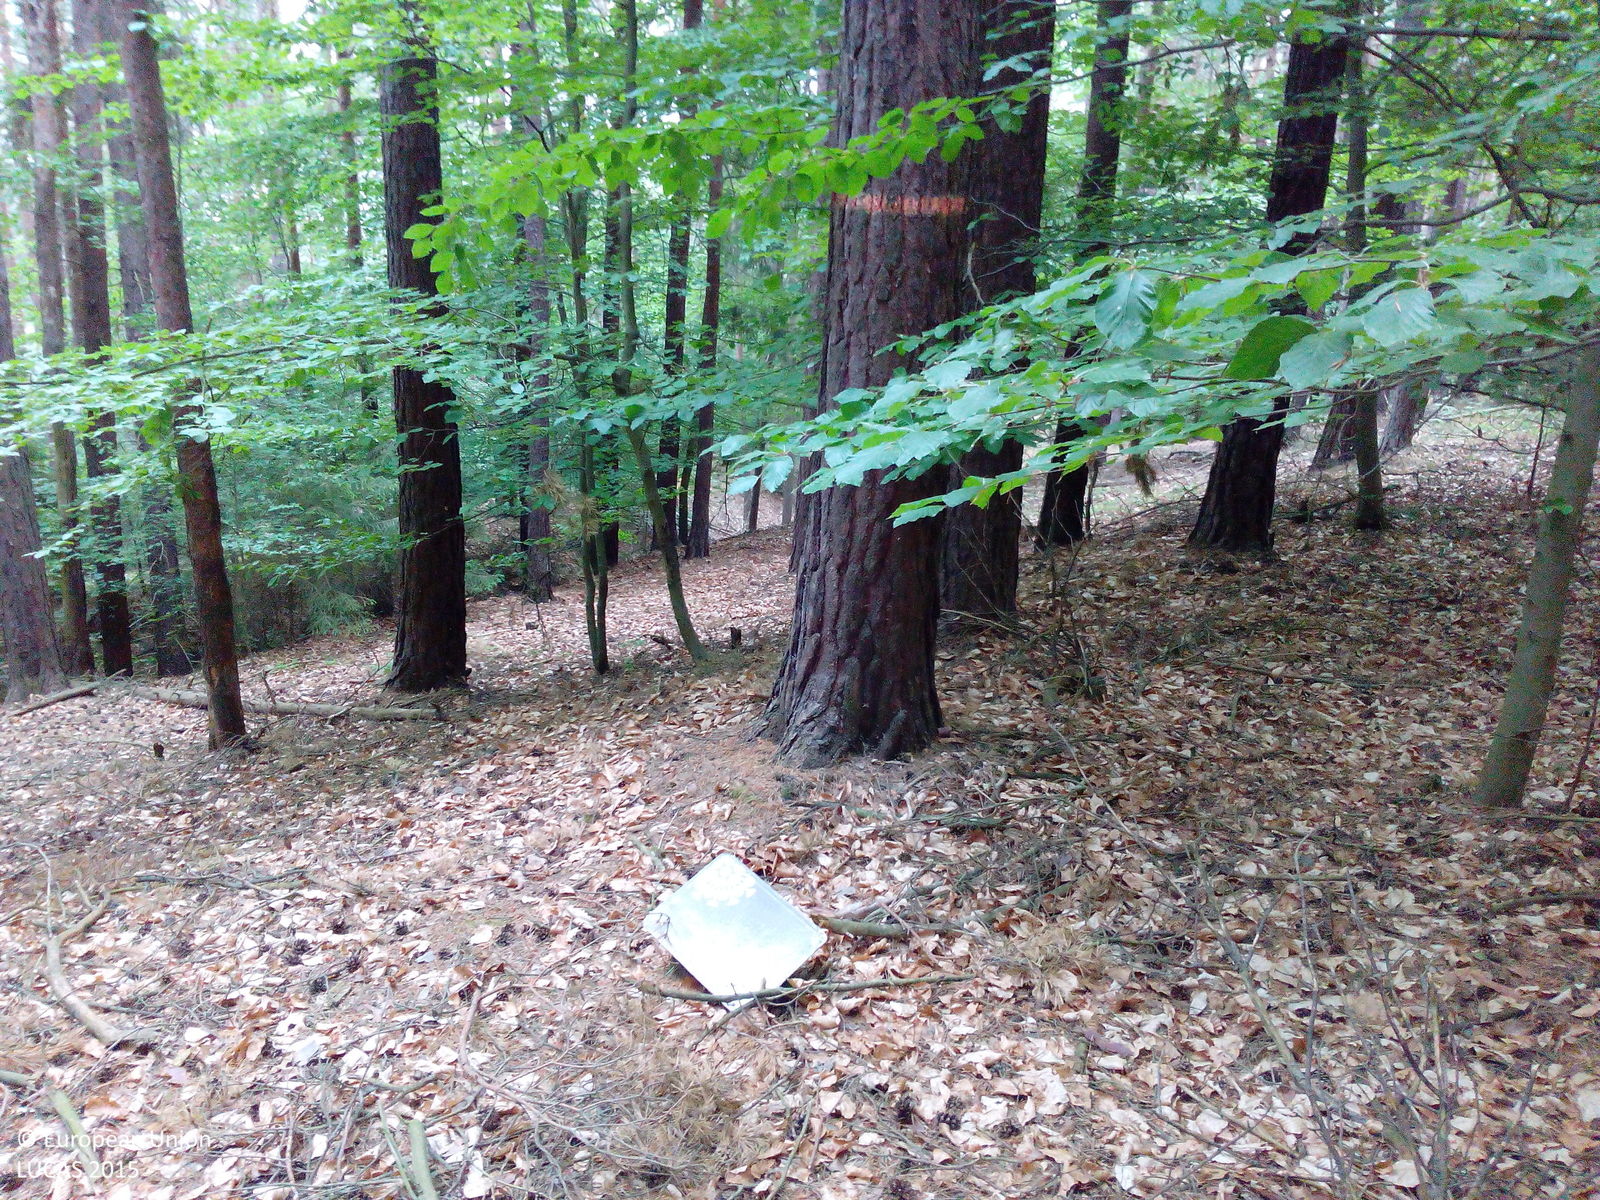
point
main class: Woodland
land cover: Other mixed woodland
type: hemiboreal forest and nemoral coniferous forest and mixed broadleaved-coniferous forest
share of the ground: > 75 %
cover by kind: coniferous forest trees 70 %, broadleaved forest trees 25 %, unconsolidated bare surface 5 %
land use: Forestry
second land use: Amenities, museums, leisure
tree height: > 5 m
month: June
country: DE
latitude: 50.6964
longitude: 11.4579
